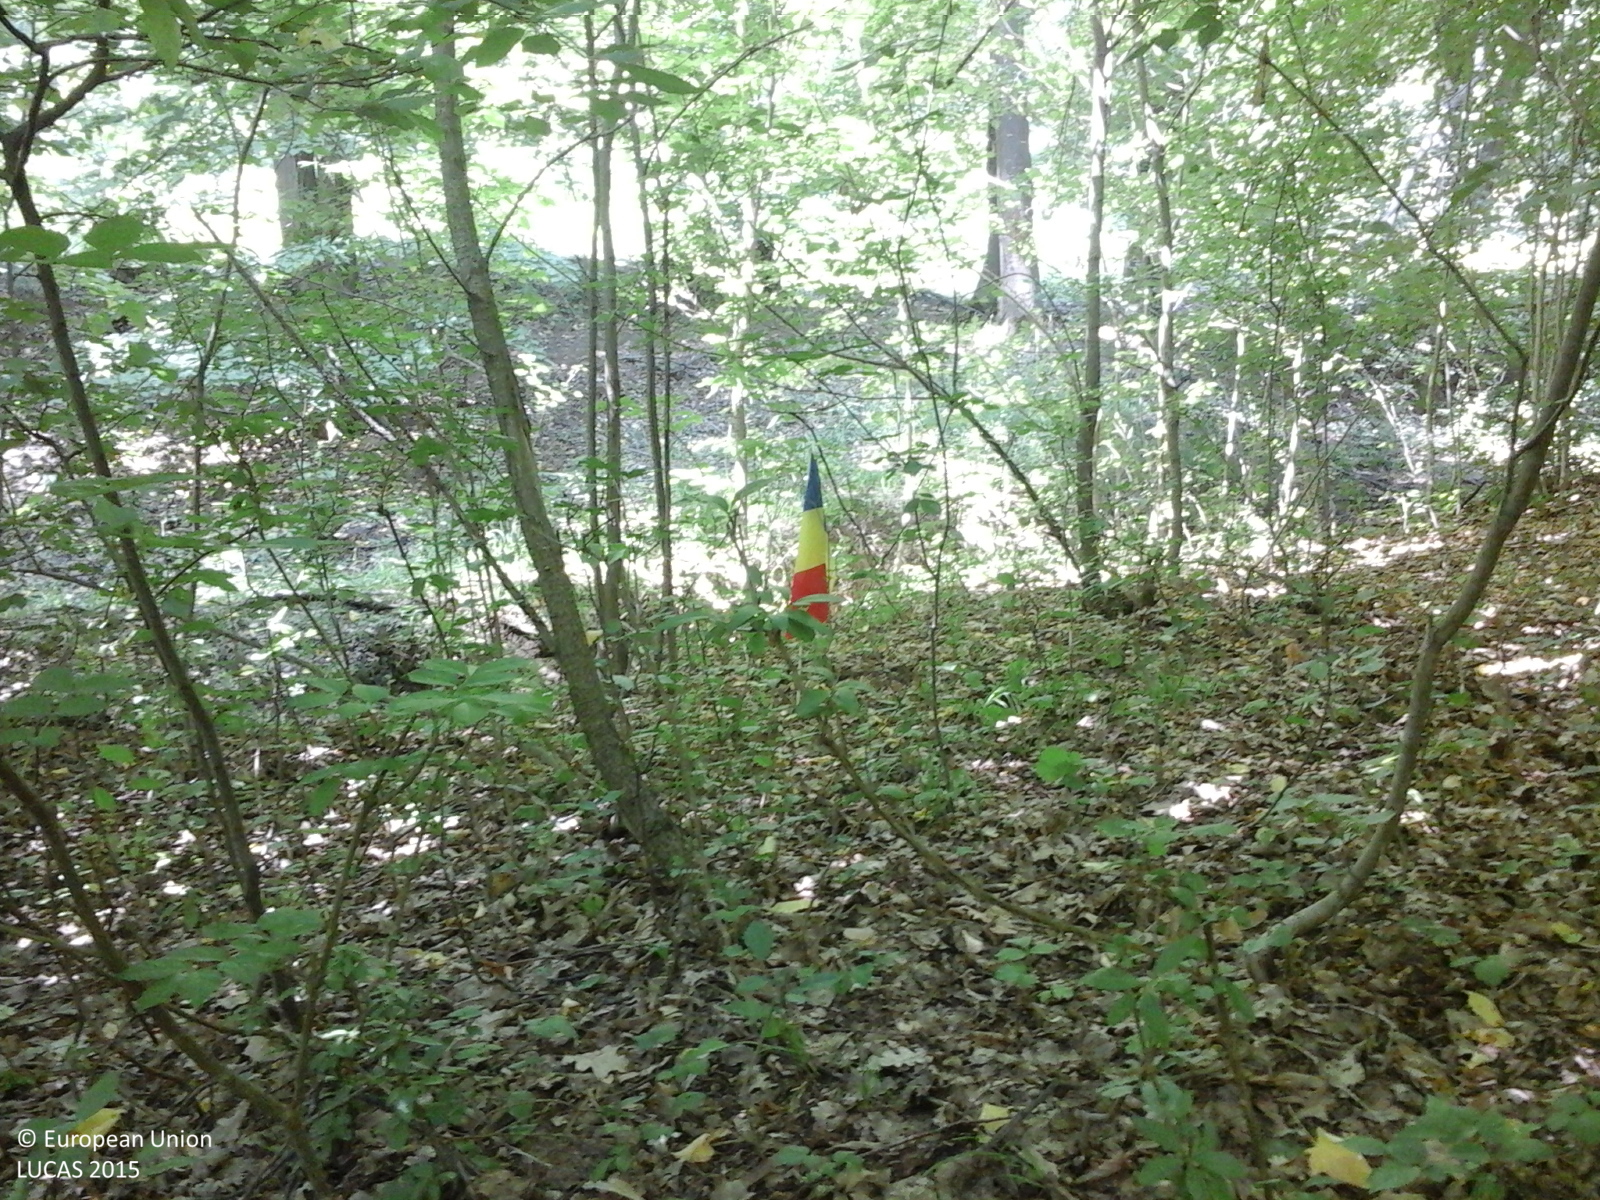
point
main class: Woodland
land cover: Broadleaved woodland
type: mesophytic deciduous forest
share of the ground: > 75 %
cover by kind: broadleaved forest trees 100 %
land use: Forestry
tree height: > 5 m
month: June
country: RO
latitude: 47.0873
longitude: 27.5983
